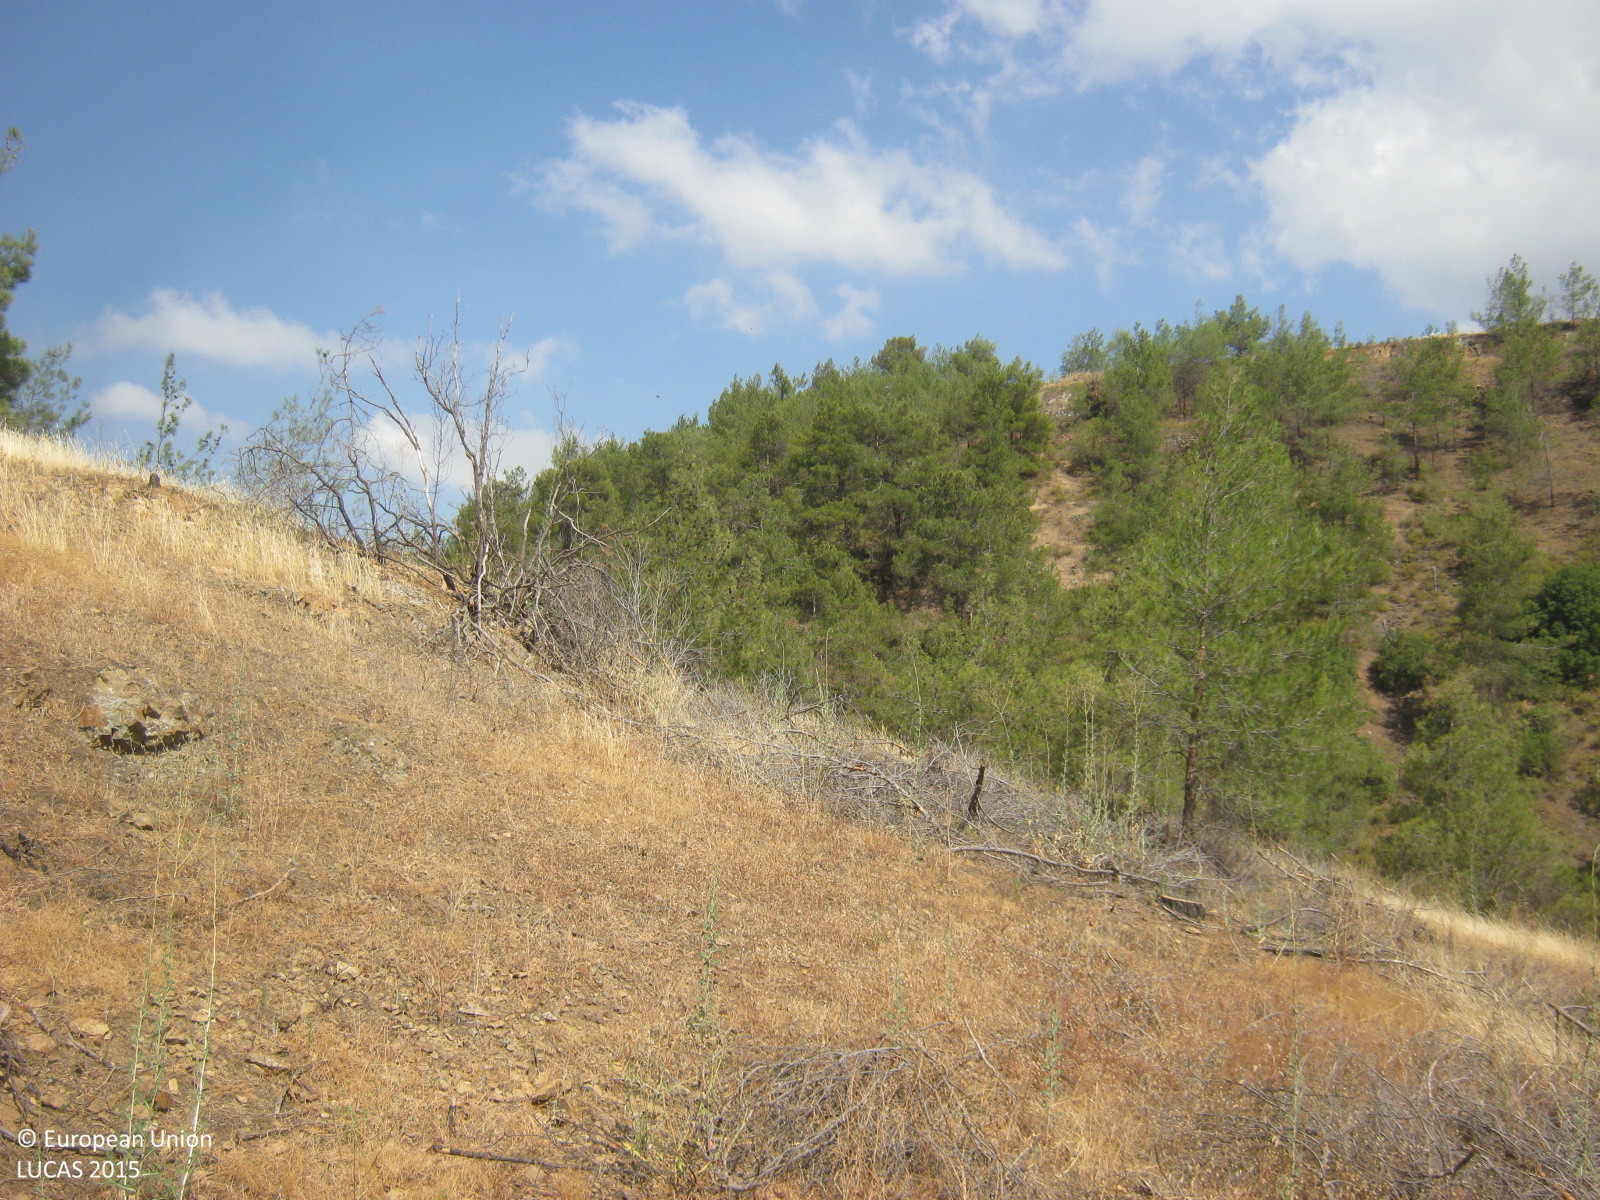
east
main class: Grassland
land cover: Grassland without tree/shrub cover
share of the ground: 10 - 25 %
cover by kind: unconsolidated bare surface 80 %, herbaceous plants 15 %, shrubs 5 %
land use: Forestry
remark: Burnt area
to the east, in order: Grassland without tree/shrub cover; Pine dominated coniferous woodland; Tracks; Pine dominated coniferous woodland; Tracks; Pine dominated coniferous woodland
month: June
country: CY
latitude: 34.9806
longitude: 33.1500
